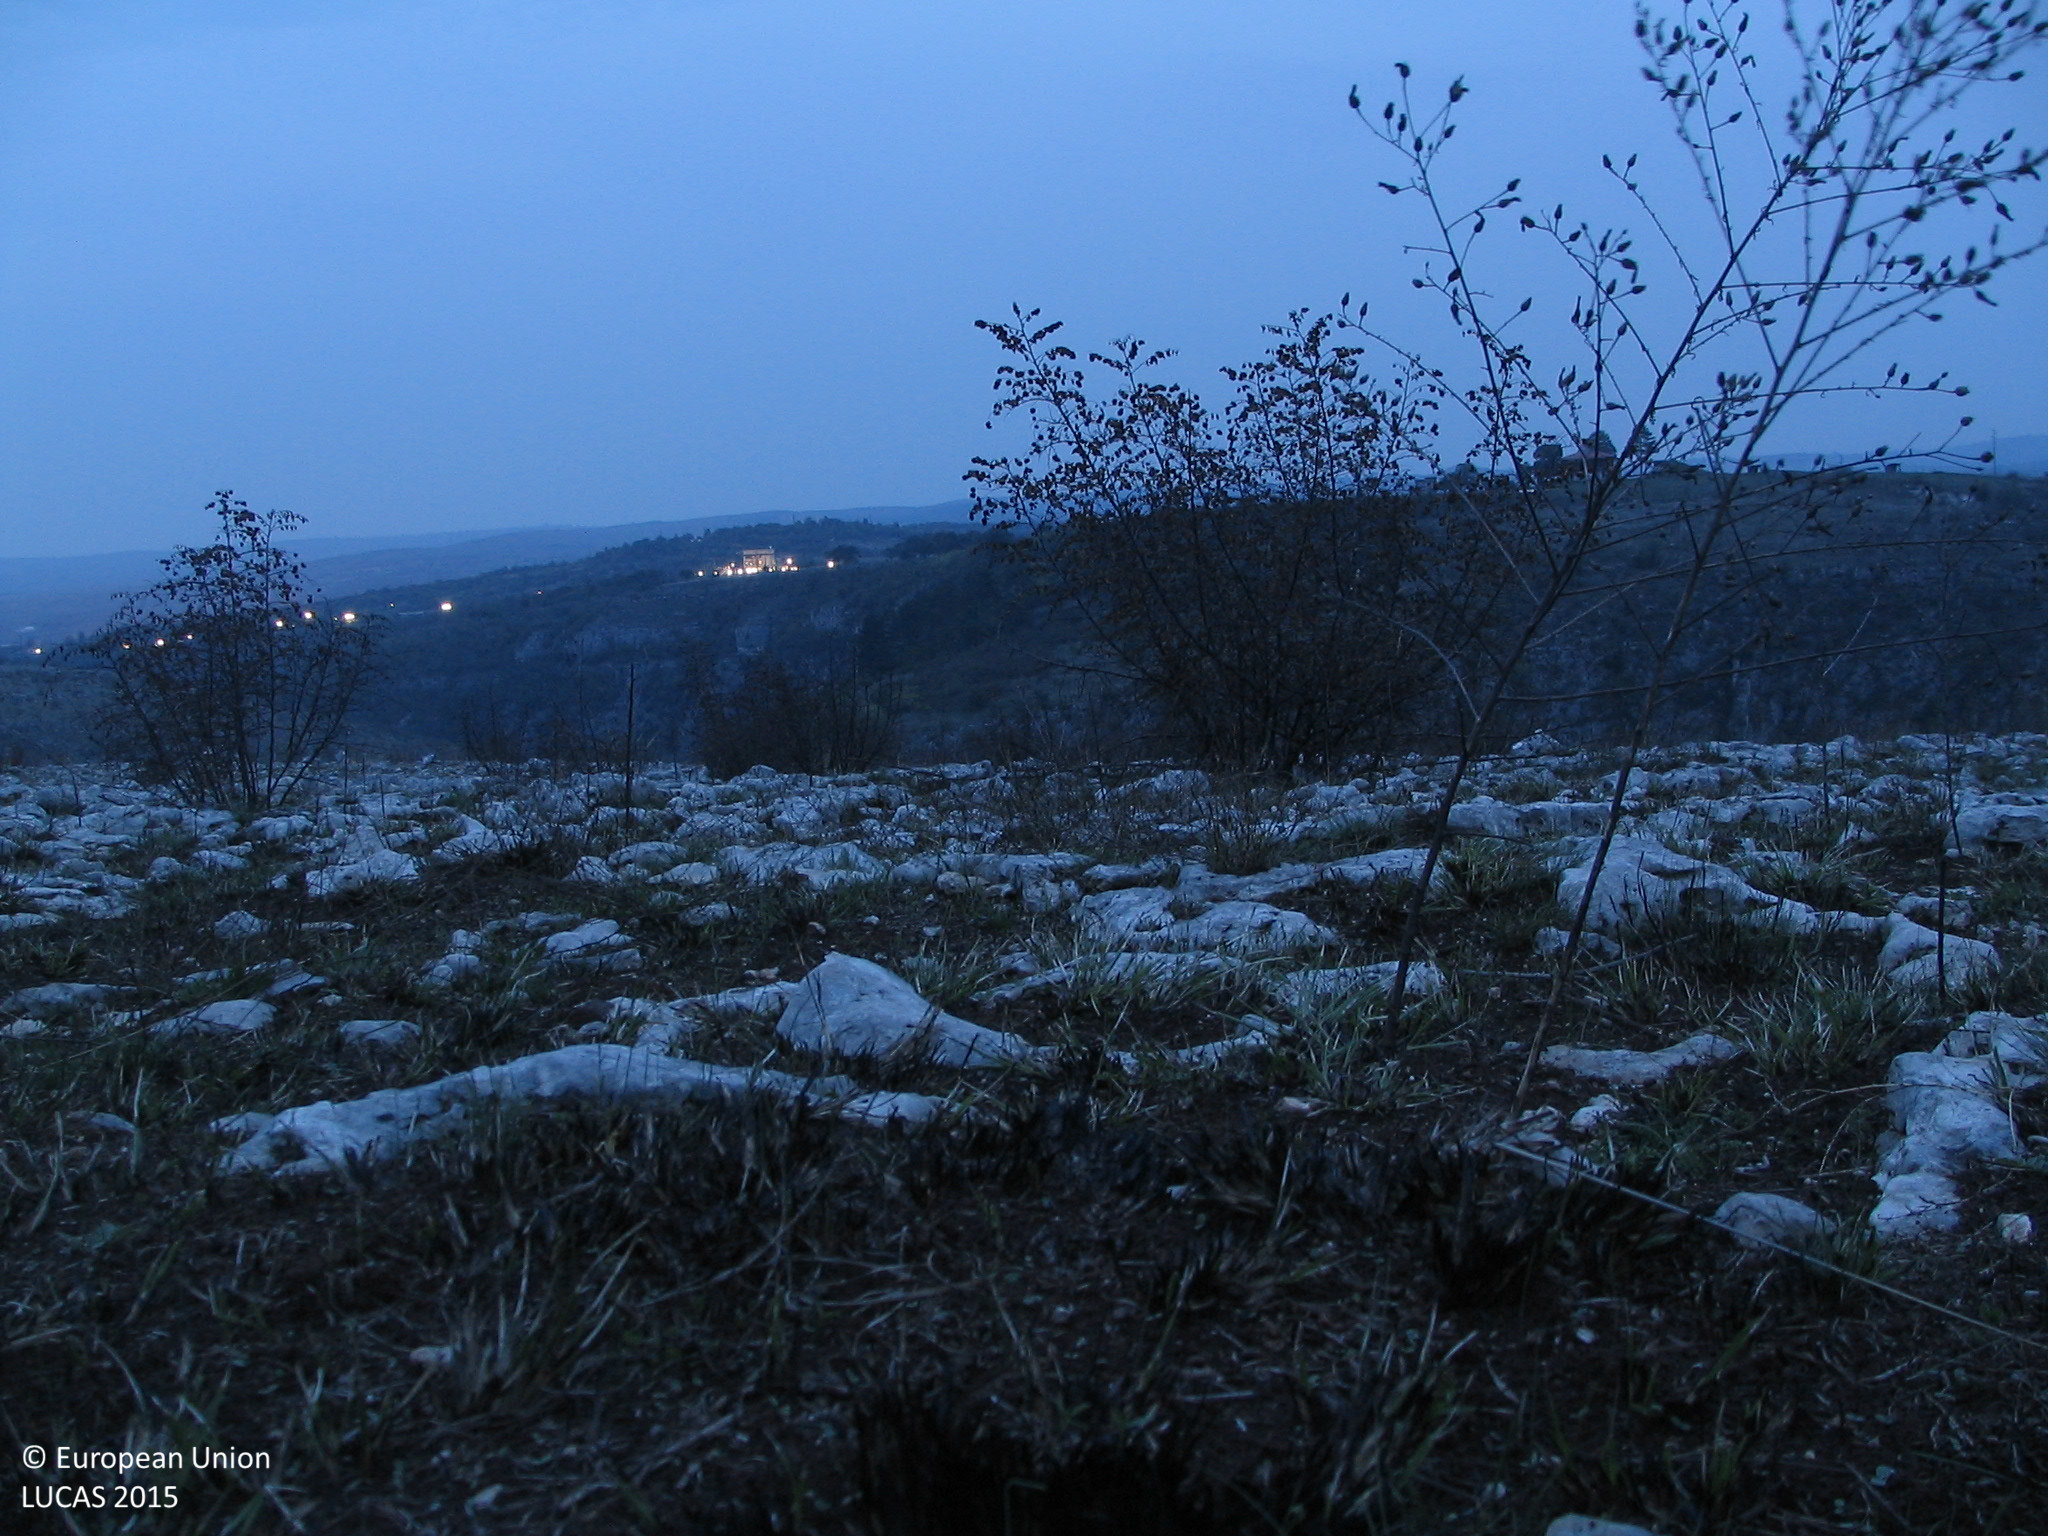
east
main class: Grassland
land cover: Grassland with sparse tree/shrub cover
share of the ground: 50 - 75 %
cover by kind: herbaceous plants 50 %, consolidated bare surface 40 %, broadleaved forest trees 5 %, shrubs 5 %
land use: Abandoned areas
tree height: < 5 m
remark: Burnt area
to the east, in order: Grassland with sparse tree/shrub cover; Rocks and stones; Grassland with sparse tree/shrub cover; Rocks and stones; Grassland with sparse tree/shrub cover; Broadleaved woodland
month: October
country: BG
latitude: 43.1934
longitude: 24.1419
